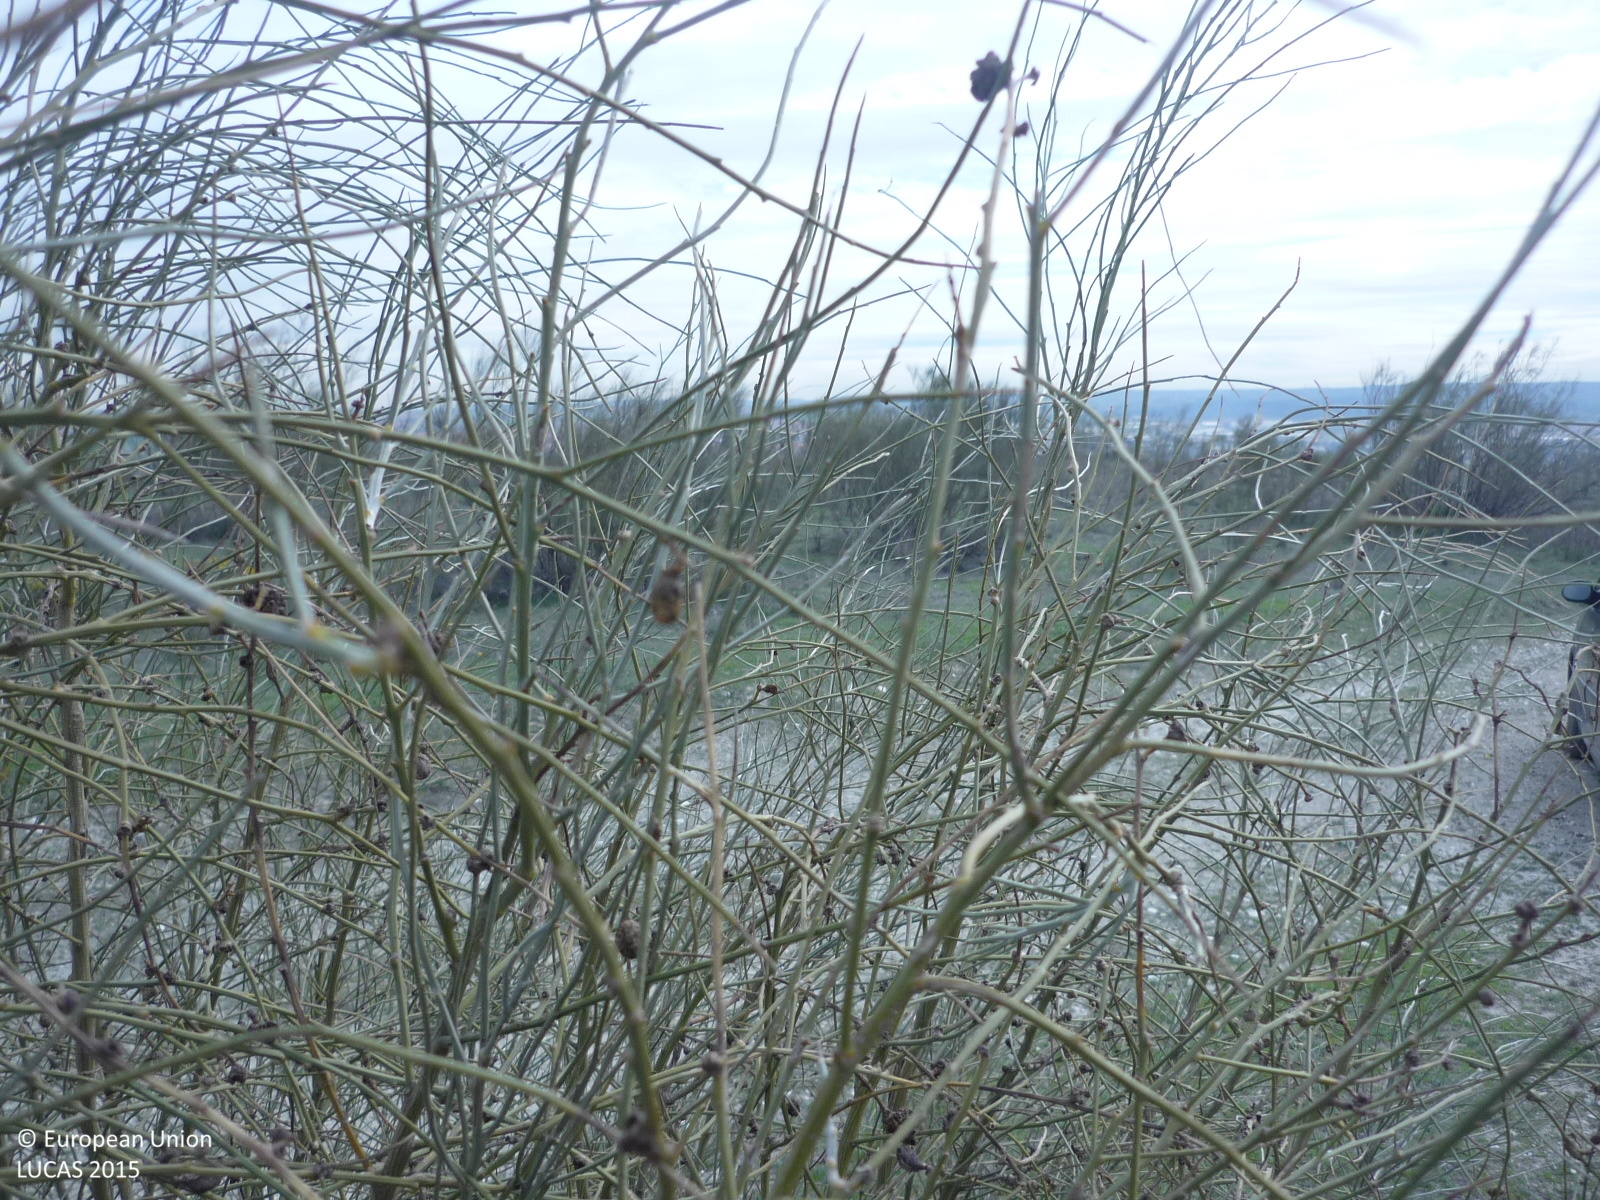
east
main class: Shrubland
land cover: Shrubland without tree cover
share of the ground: 10 - 25 %
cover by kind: herbaceous plants 70 %, shrubs 15 %, unconsolidated bare surface 15 %
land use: Semi-natural and natural areas not in use
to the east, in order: Shrubland without tree cover; Tracks; Shrubland without tree cover; Tracks; Shrubland without tree cover; Inland fresh water bodies
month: March
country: ES
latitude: 40.3884
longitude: -3.5232
